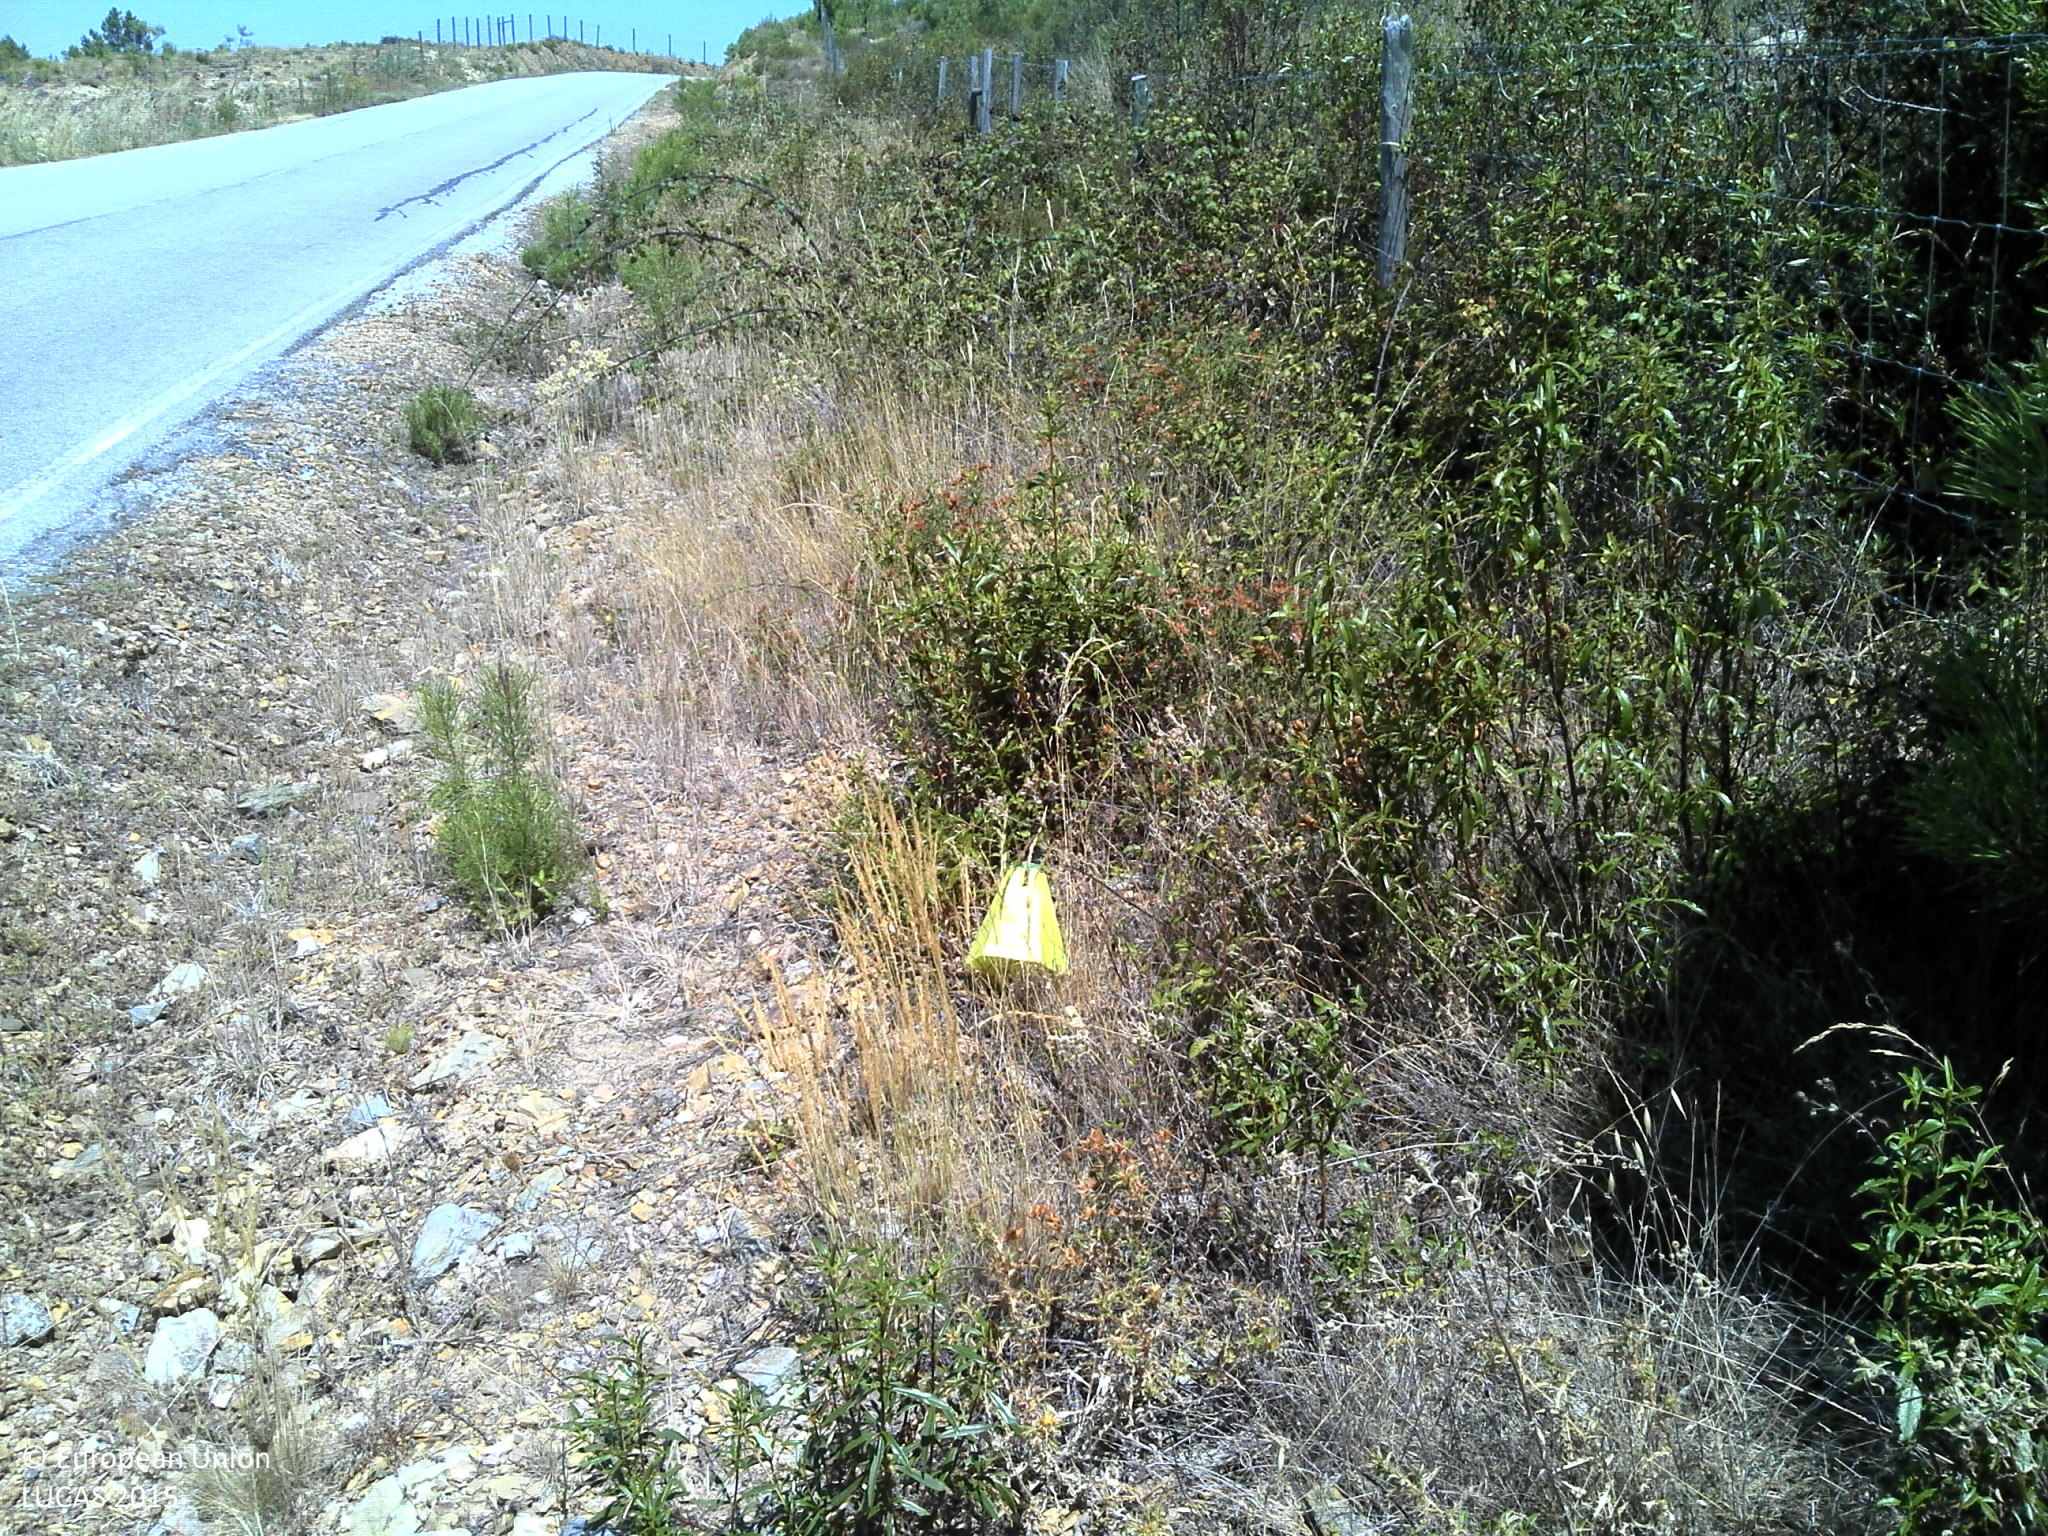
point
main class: Woodland
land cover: Pine dominated coniferous woodland
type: coniferous forest of the mediterranean region
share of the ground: 10 - 25 %
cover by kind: shrubs 85 %, coniferous forest trees 15 %
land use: Forestry
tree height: > 5 m
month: August
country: PT
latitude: 39.3119
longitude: -7.3792
